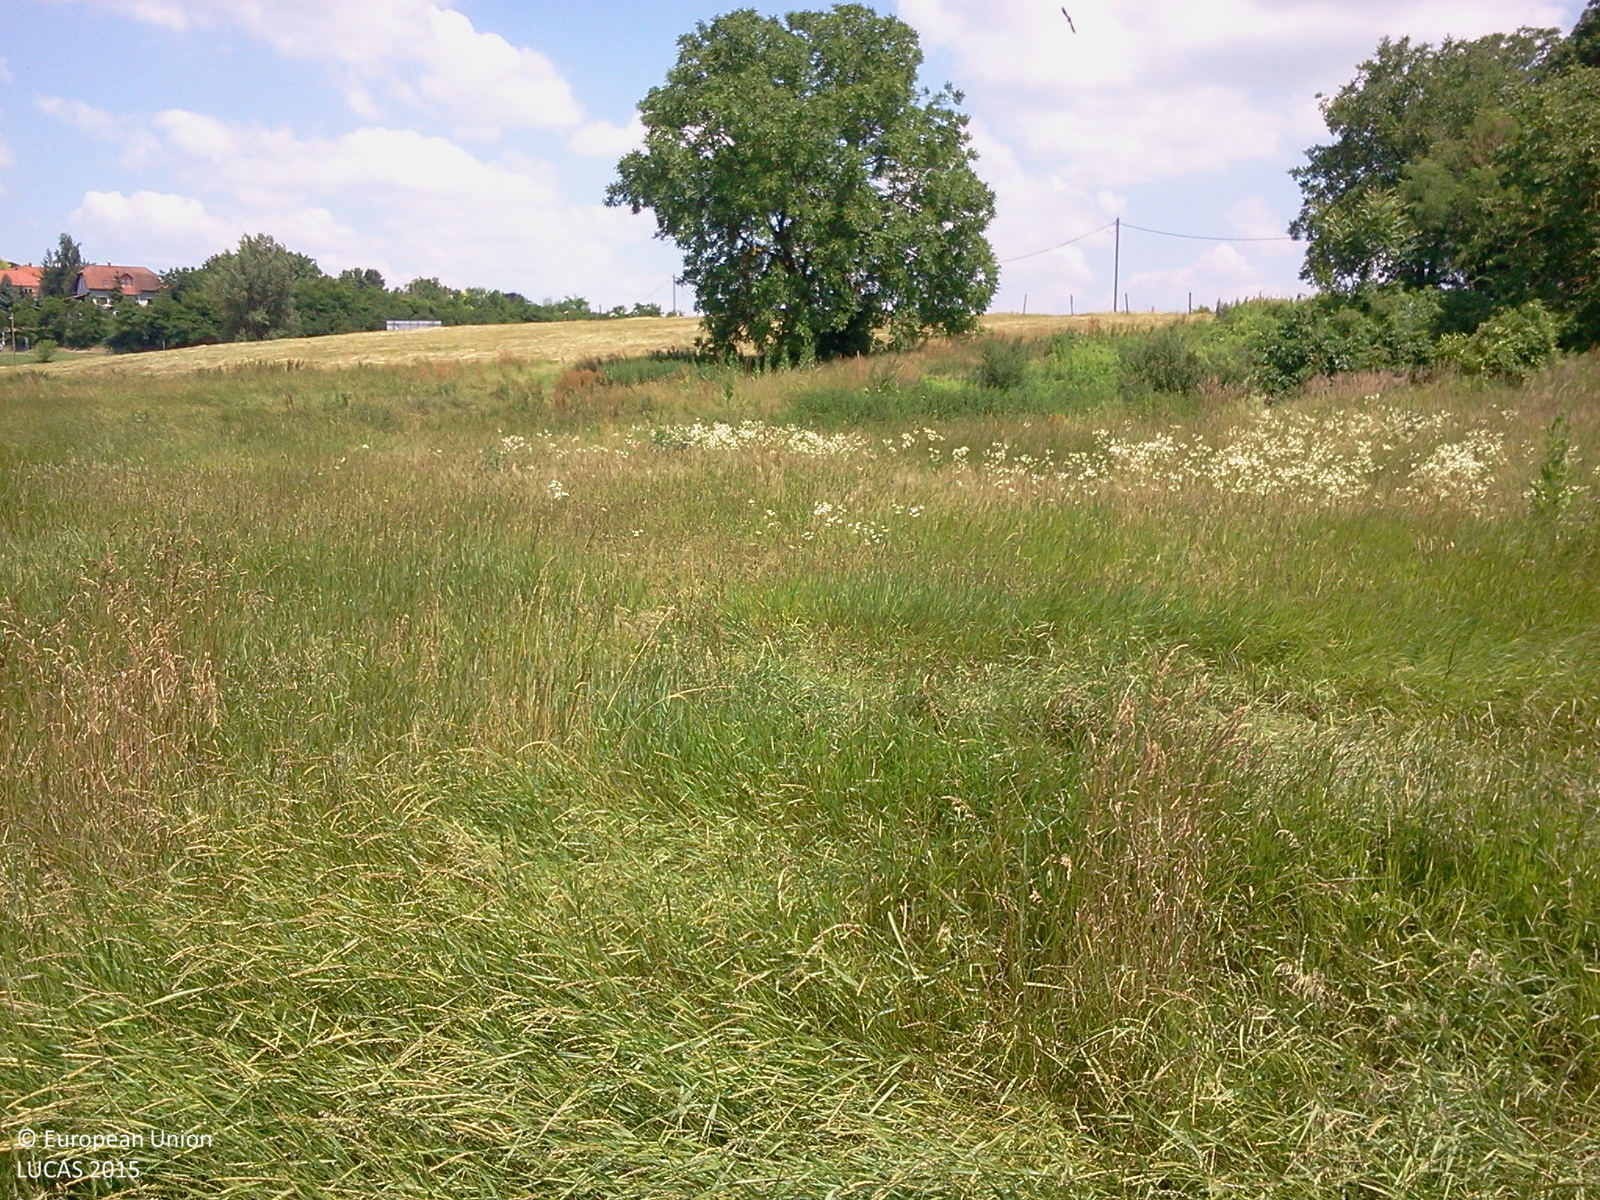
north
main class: Grassland
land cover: Grassland without tree/shrub cover
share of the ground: > 75 %
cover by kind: herbaceous plants 100 %
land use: Agriculture (excluding fallow land and kitchen gardens)
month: June
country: HU
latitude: 46.8025
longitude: 17.0929
